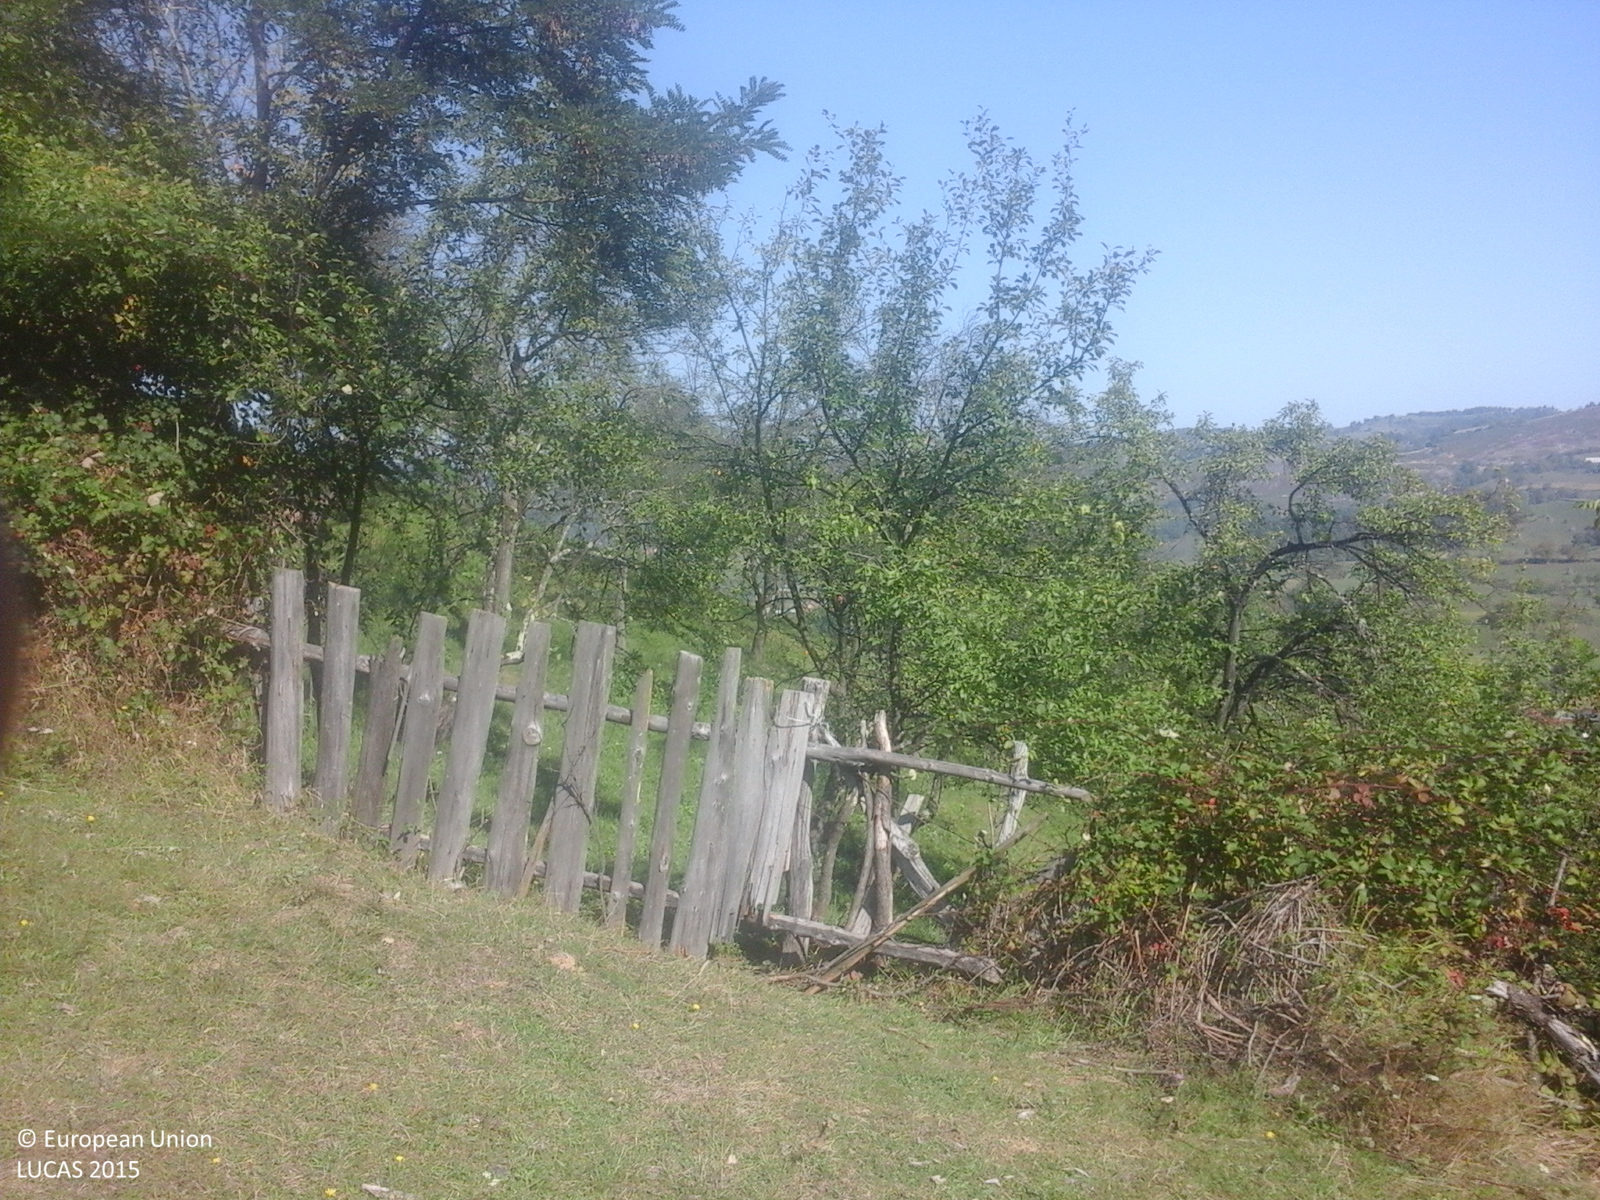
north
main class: Grassland
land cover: Grassland without tree/shrub cover
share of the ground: > 75 %
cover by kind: herbaceous plants 100 %
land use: Agriculture (excluding fallow land and kitchen gardens)
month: September
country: RO
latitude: 46.8121
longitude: 22.3836
